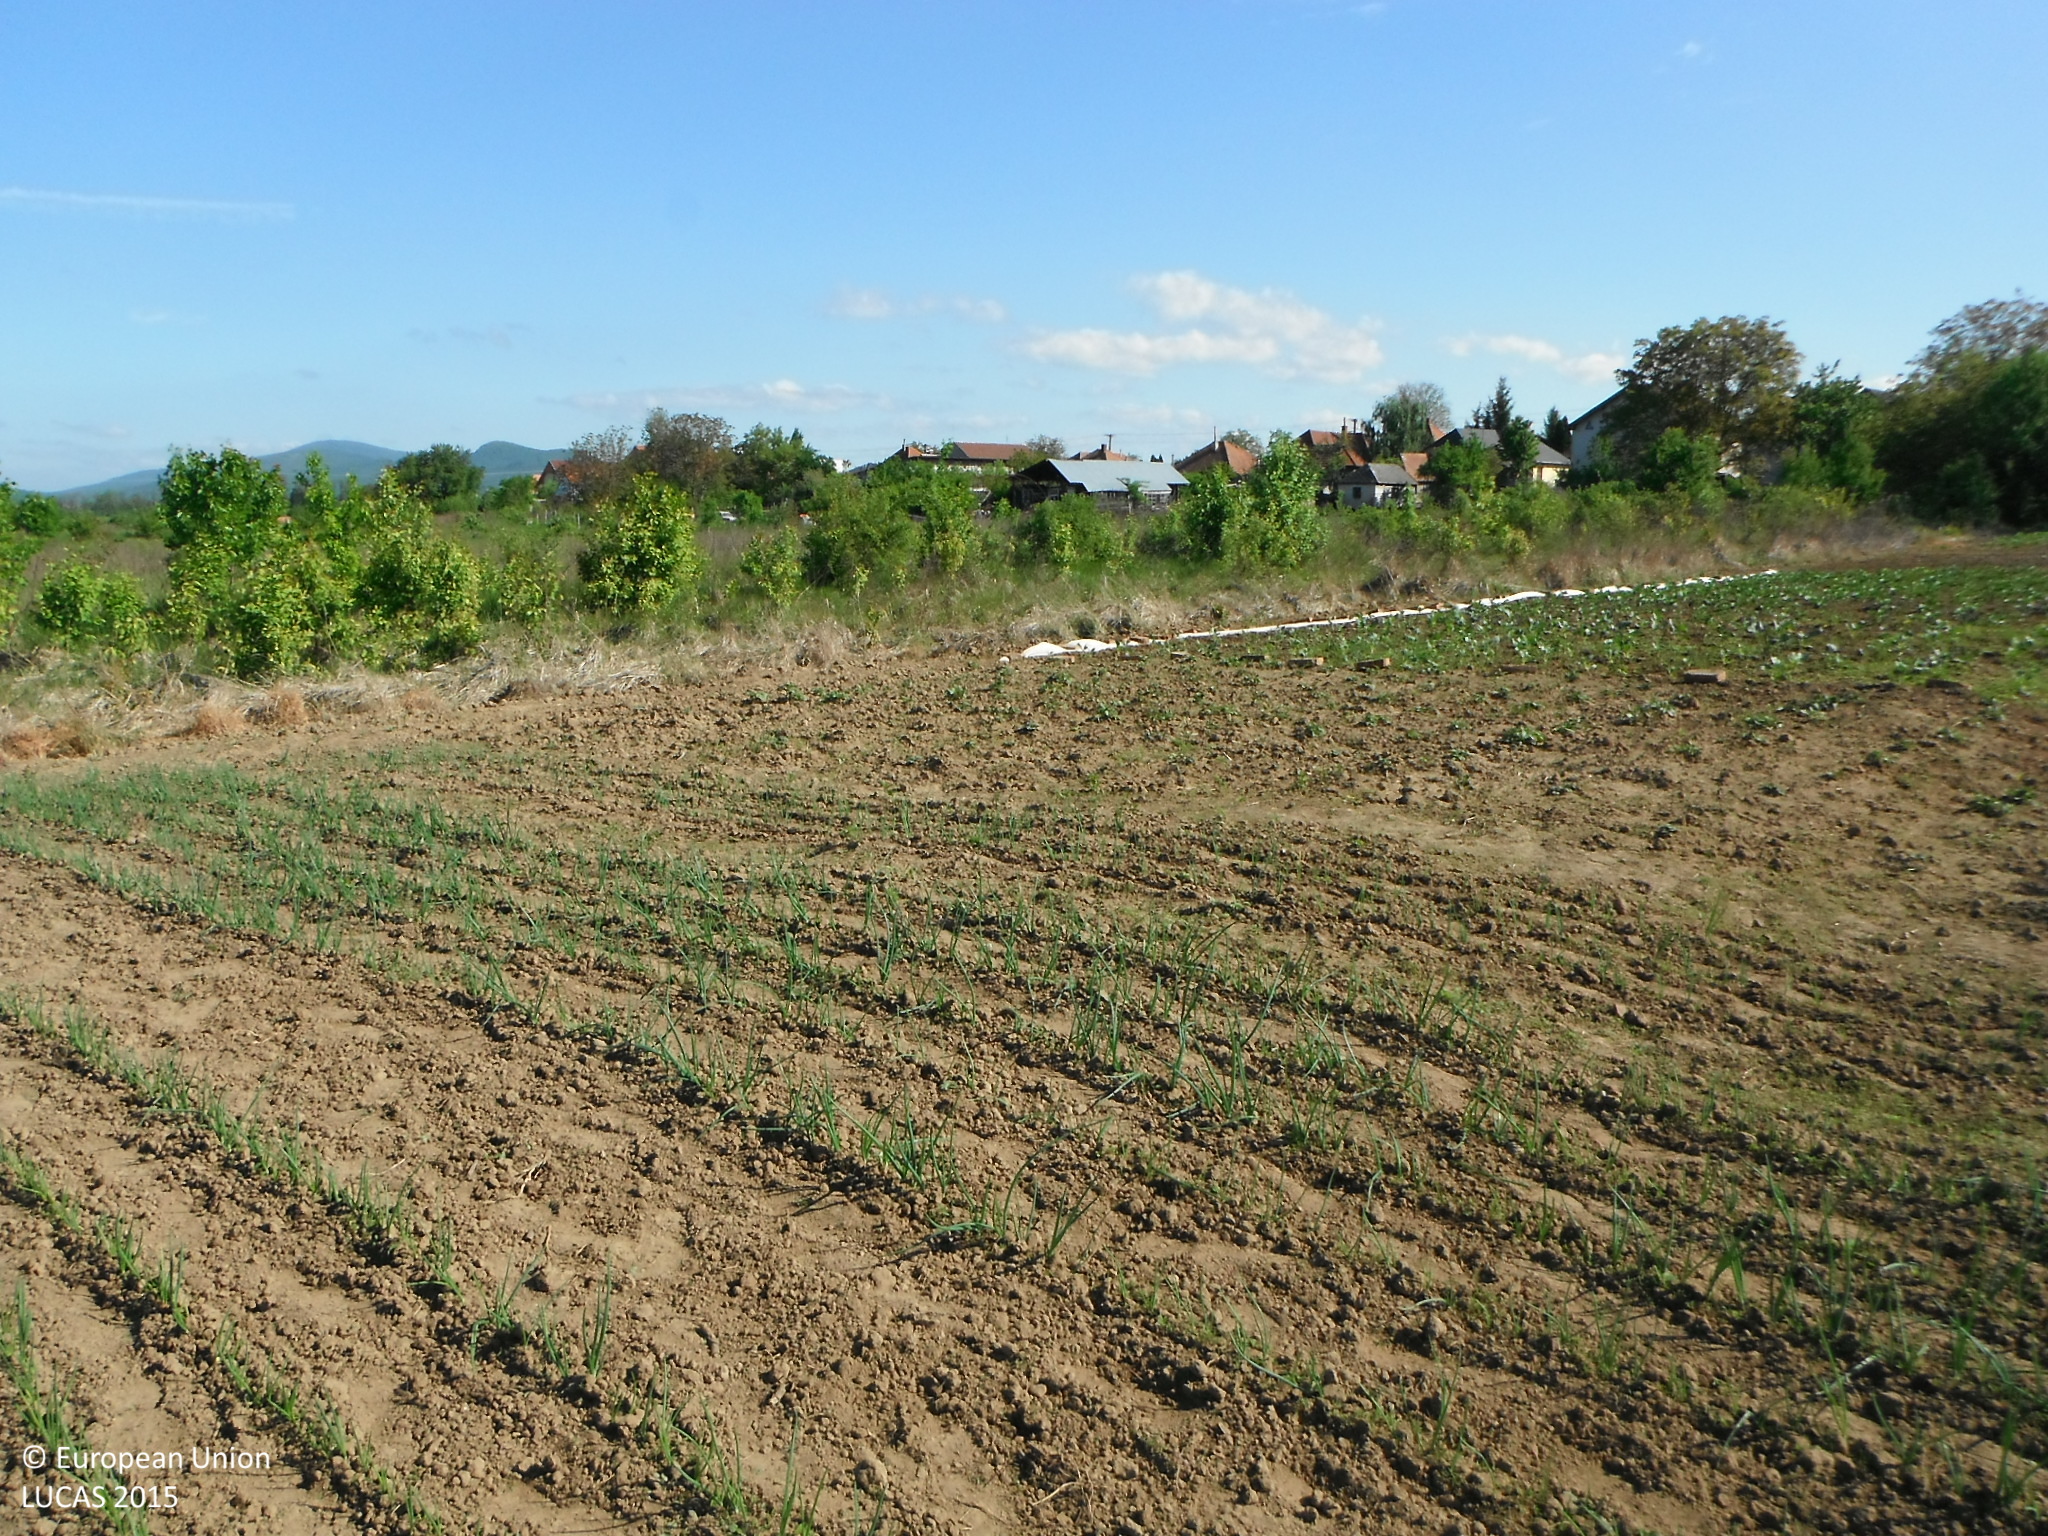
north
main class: Cropland
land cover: Other root crops
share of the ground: 10 - 25 %
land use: Kitchen garden
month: May
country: SK
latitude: 48.3453
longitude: 18.2860
